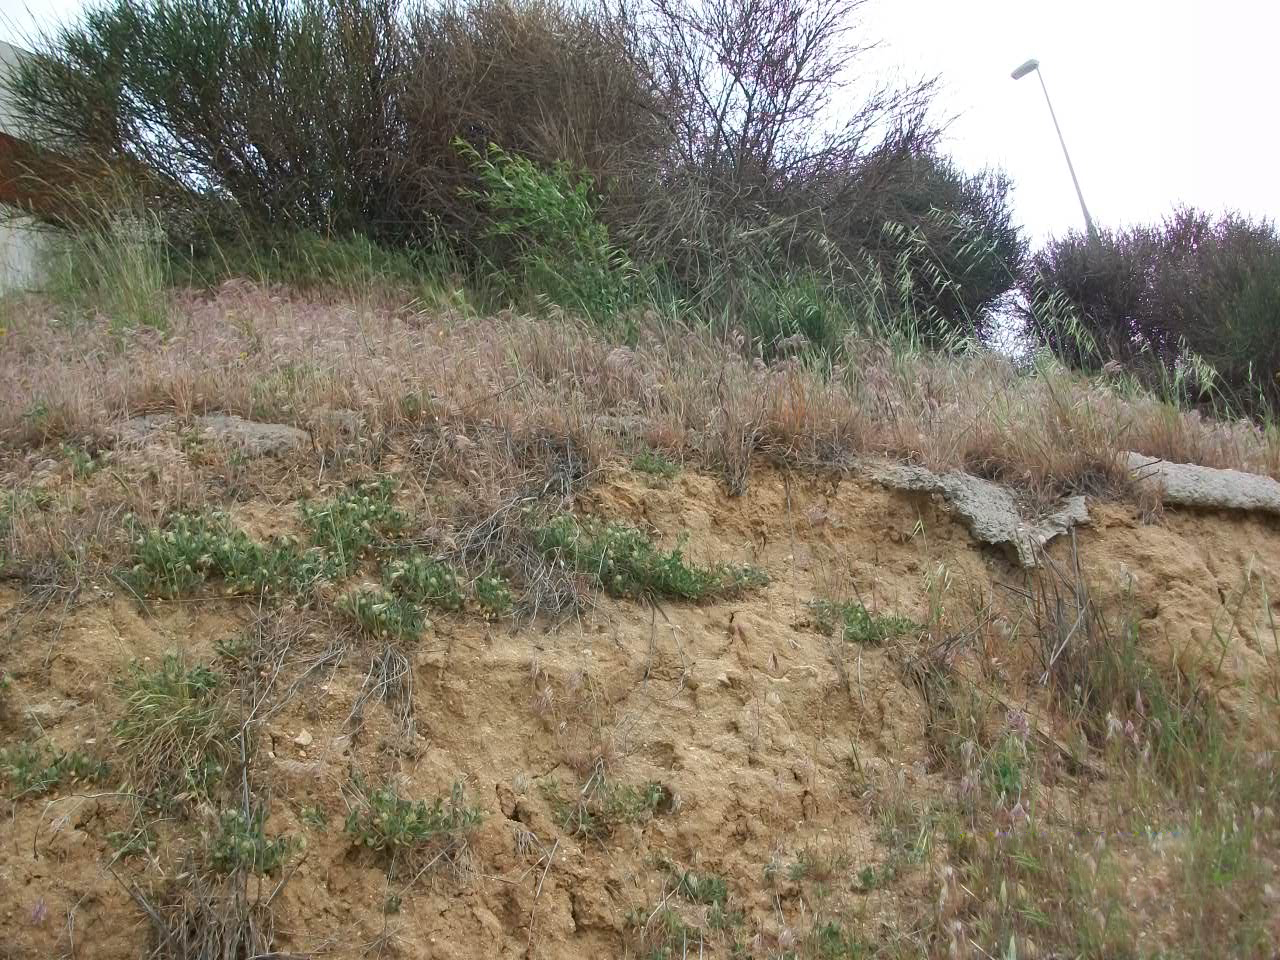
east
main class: Shrubland
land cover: Shrubland without tree cover
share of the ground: > 75 %
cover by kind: shrubs 95 %, herbaceous plants 5 %
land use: Abandoned areas
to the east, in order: Shrubland without tree cover; Paved roads, cycling and walking lanes; Shrubland without tree cover; Tracks; Shrubland without tree cover; Electric lines; Pine dominated mixed woodland; Paved roads, cycling and walking lanes; Electric lines; Shrubland with sparse tree cover; Artificial constructions in urban areas
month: April
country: ES
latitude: 40.2751
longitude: -3.8088
